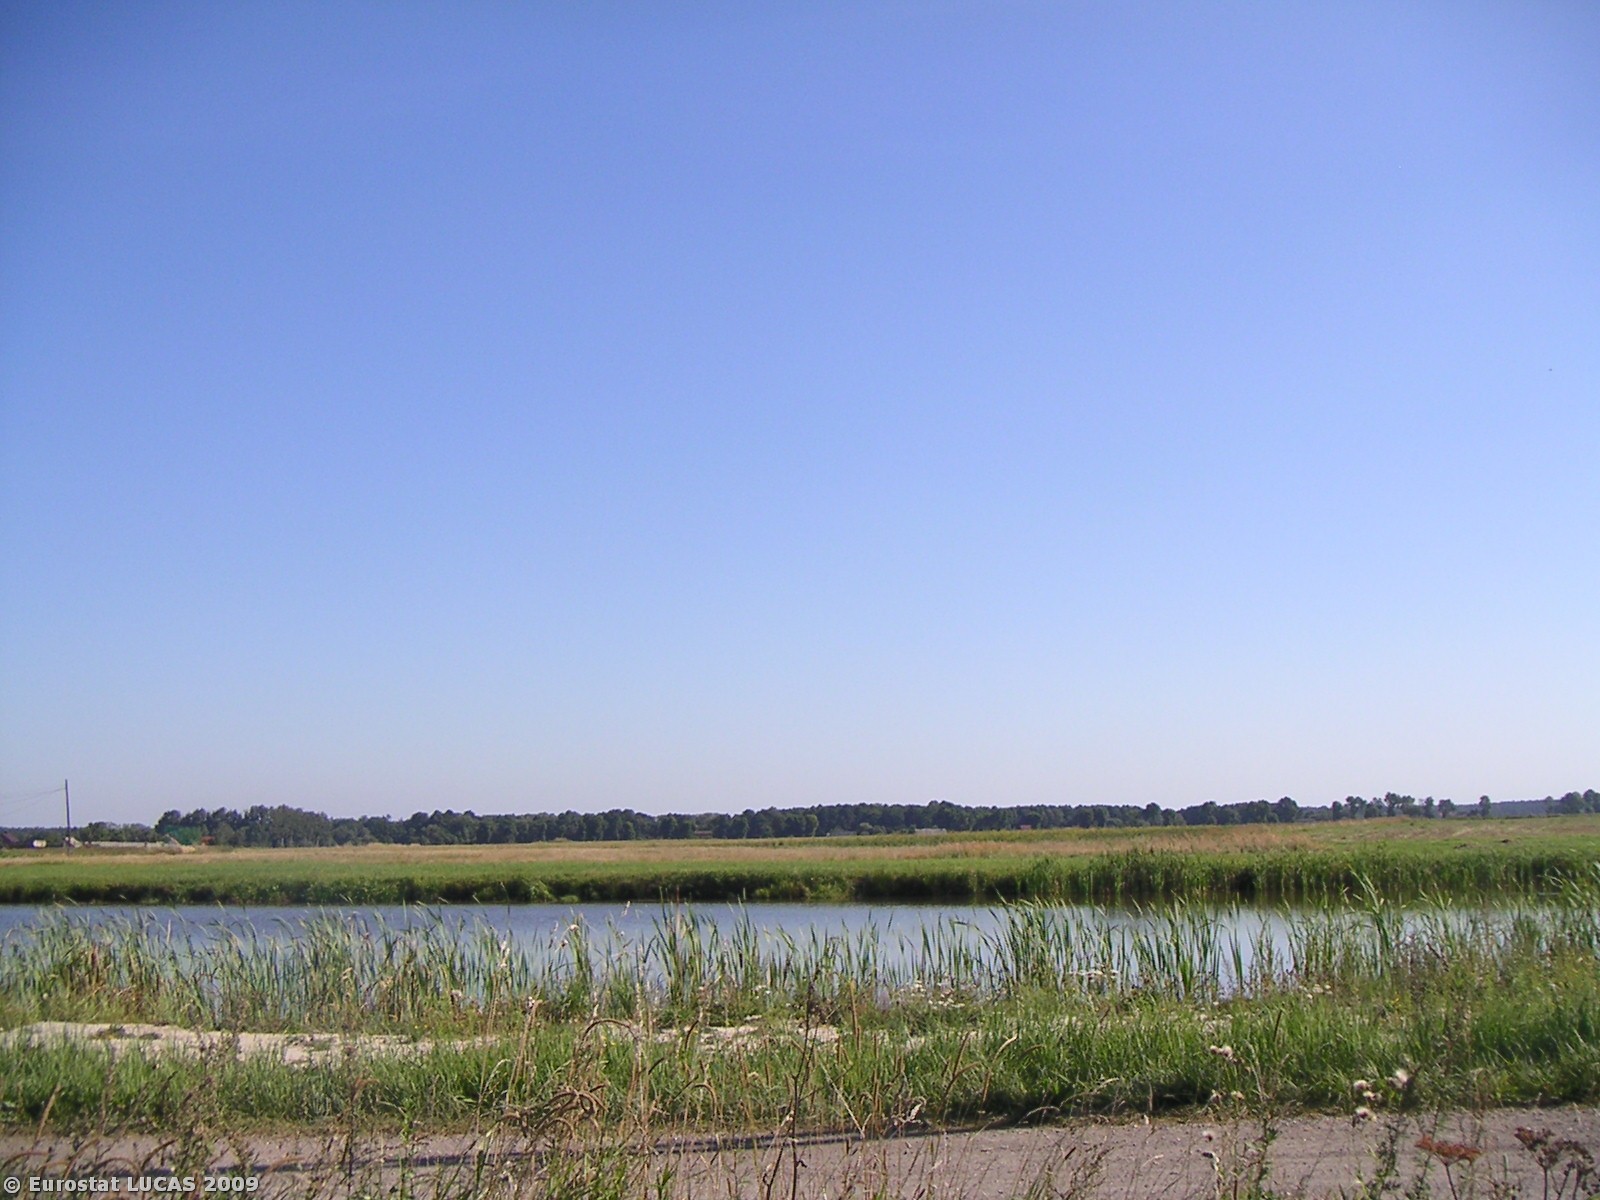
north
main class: Grassland
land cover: Grassland without tree/shrub cover
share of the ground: > 75 %
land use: Agriculture (excluding fallow land and kitchen gardens)
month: August
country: PL
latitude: 50.6927
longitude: 18.8127
